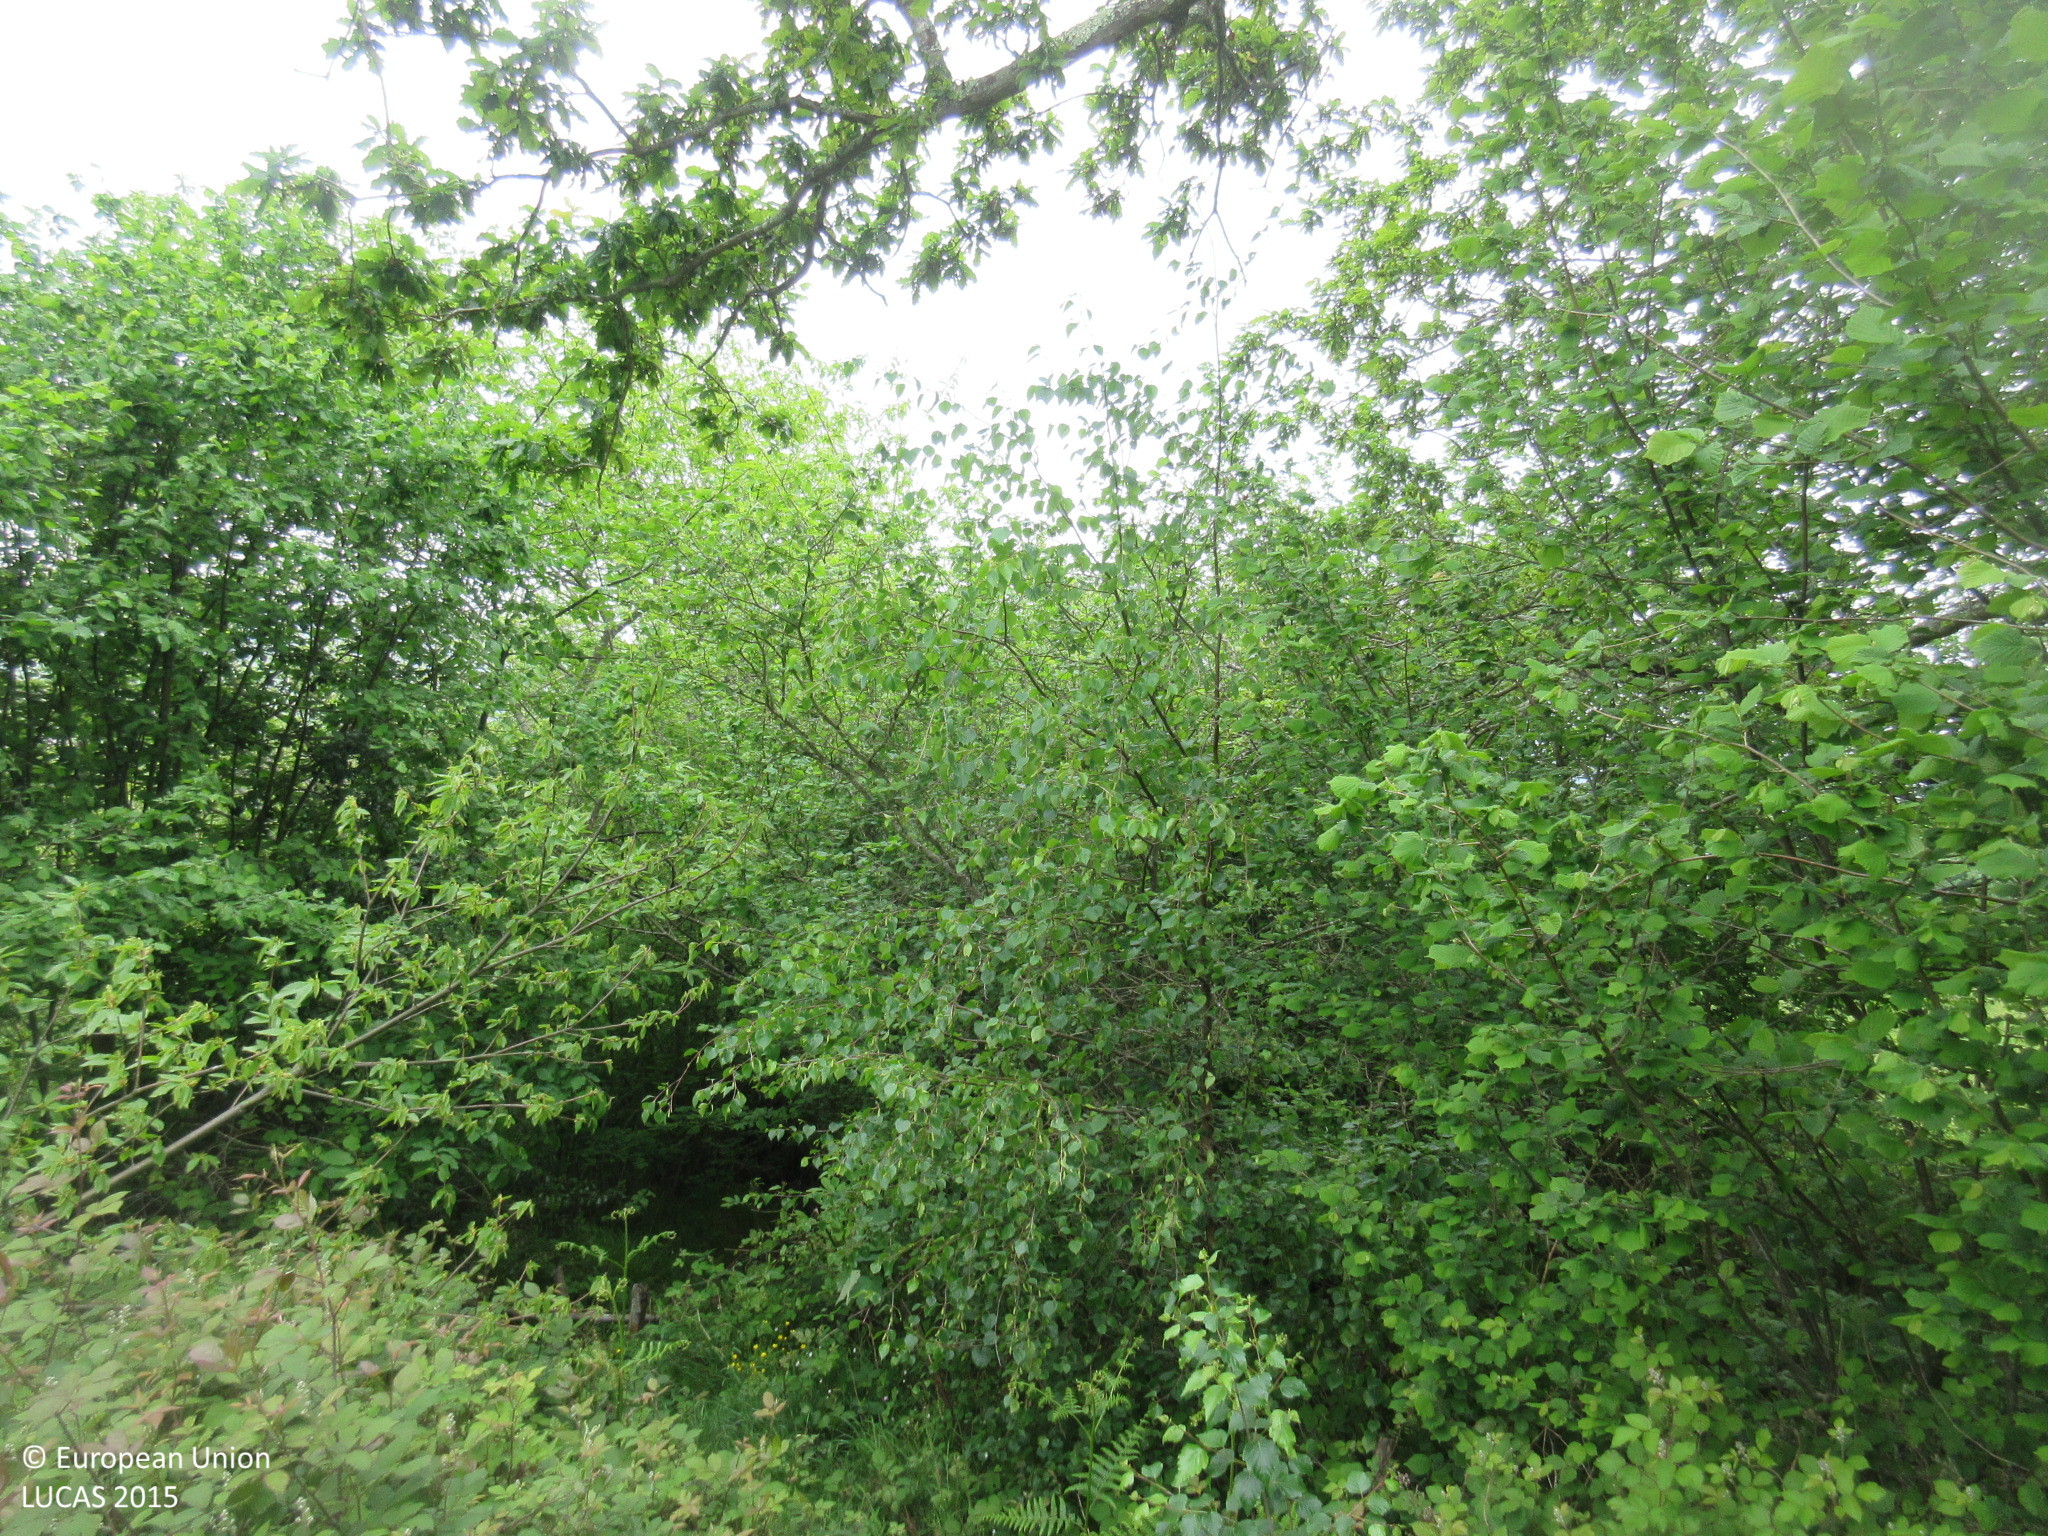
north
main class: Grassland
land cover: Grassland with sparse tree/shrub cover
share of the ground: > 75 %
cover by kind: herbaceous plants 90 %, broadleaved forest trees 5 %, shrubs 5 %
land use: Agriculture (excluding fallow land and kitchen gardens)
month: May
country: ES
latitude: 43.3333
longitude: -5.5597
